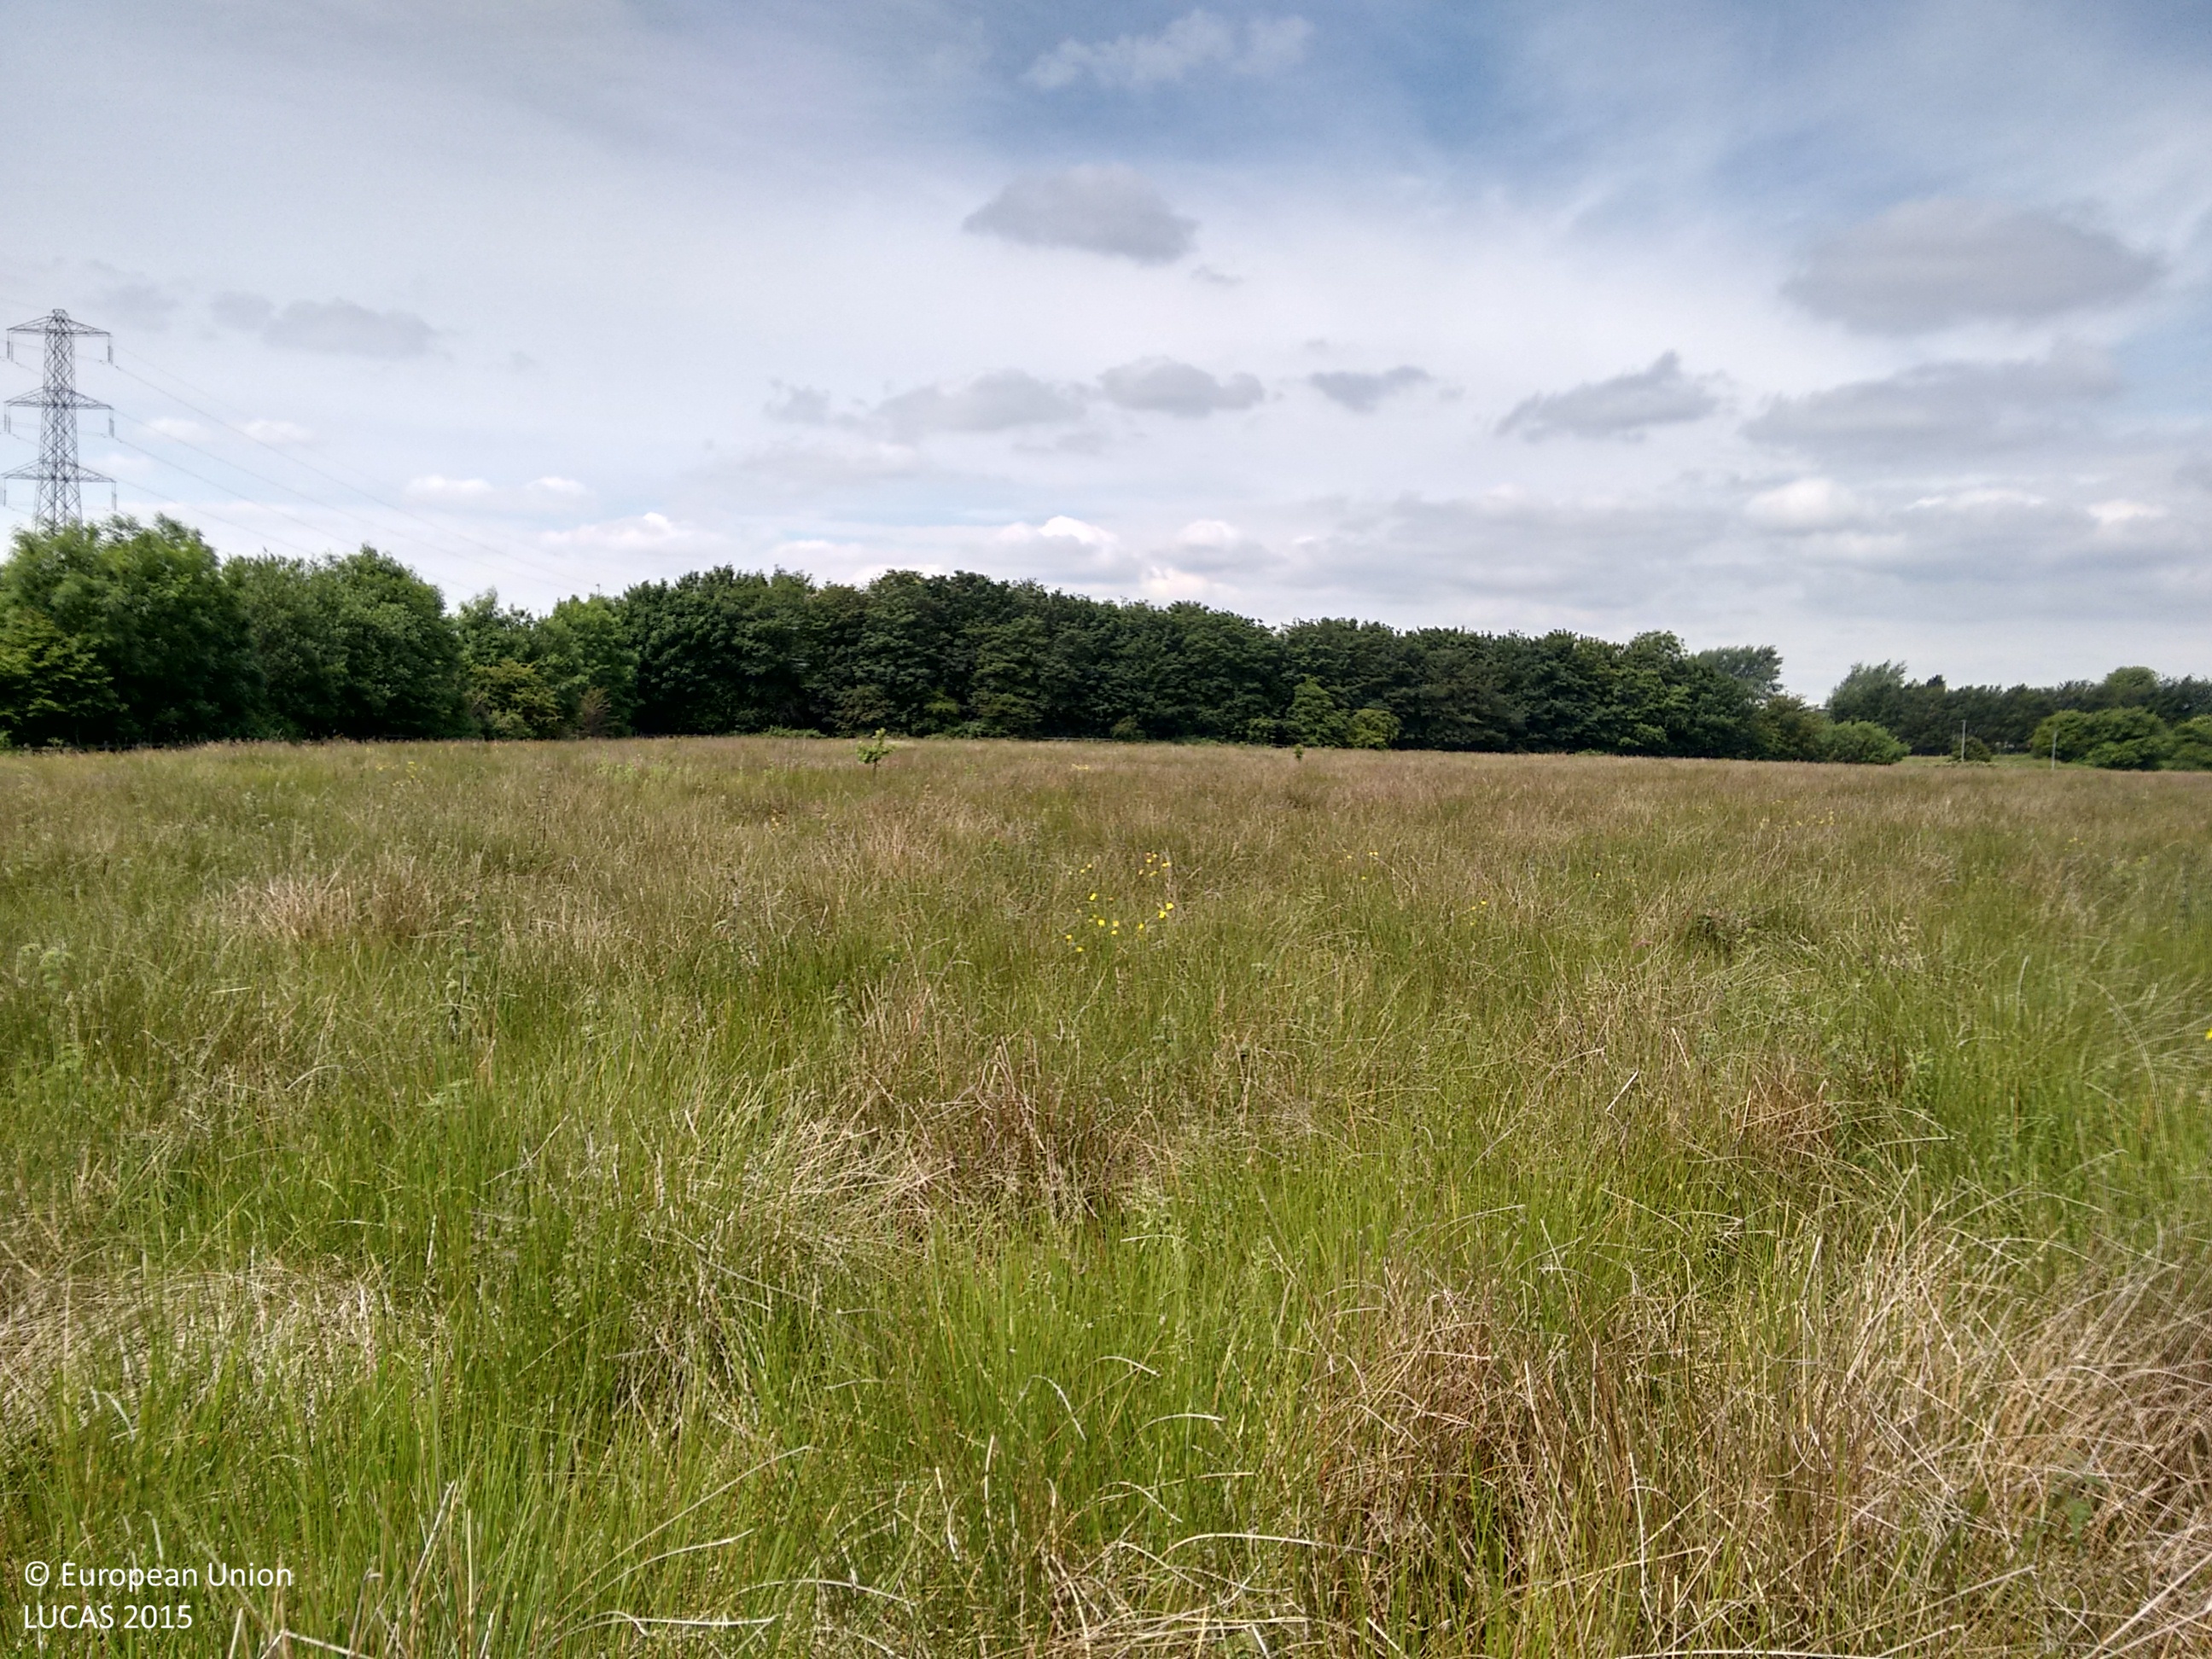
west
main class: Grassland
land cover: Grassland without tree/shrub cover
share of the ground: > 75 %
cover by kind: herbaceous plants 100 %
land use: Semi-natural and natural areas not in use
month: June
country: GB
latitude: 53.5418
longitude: -2.4231
